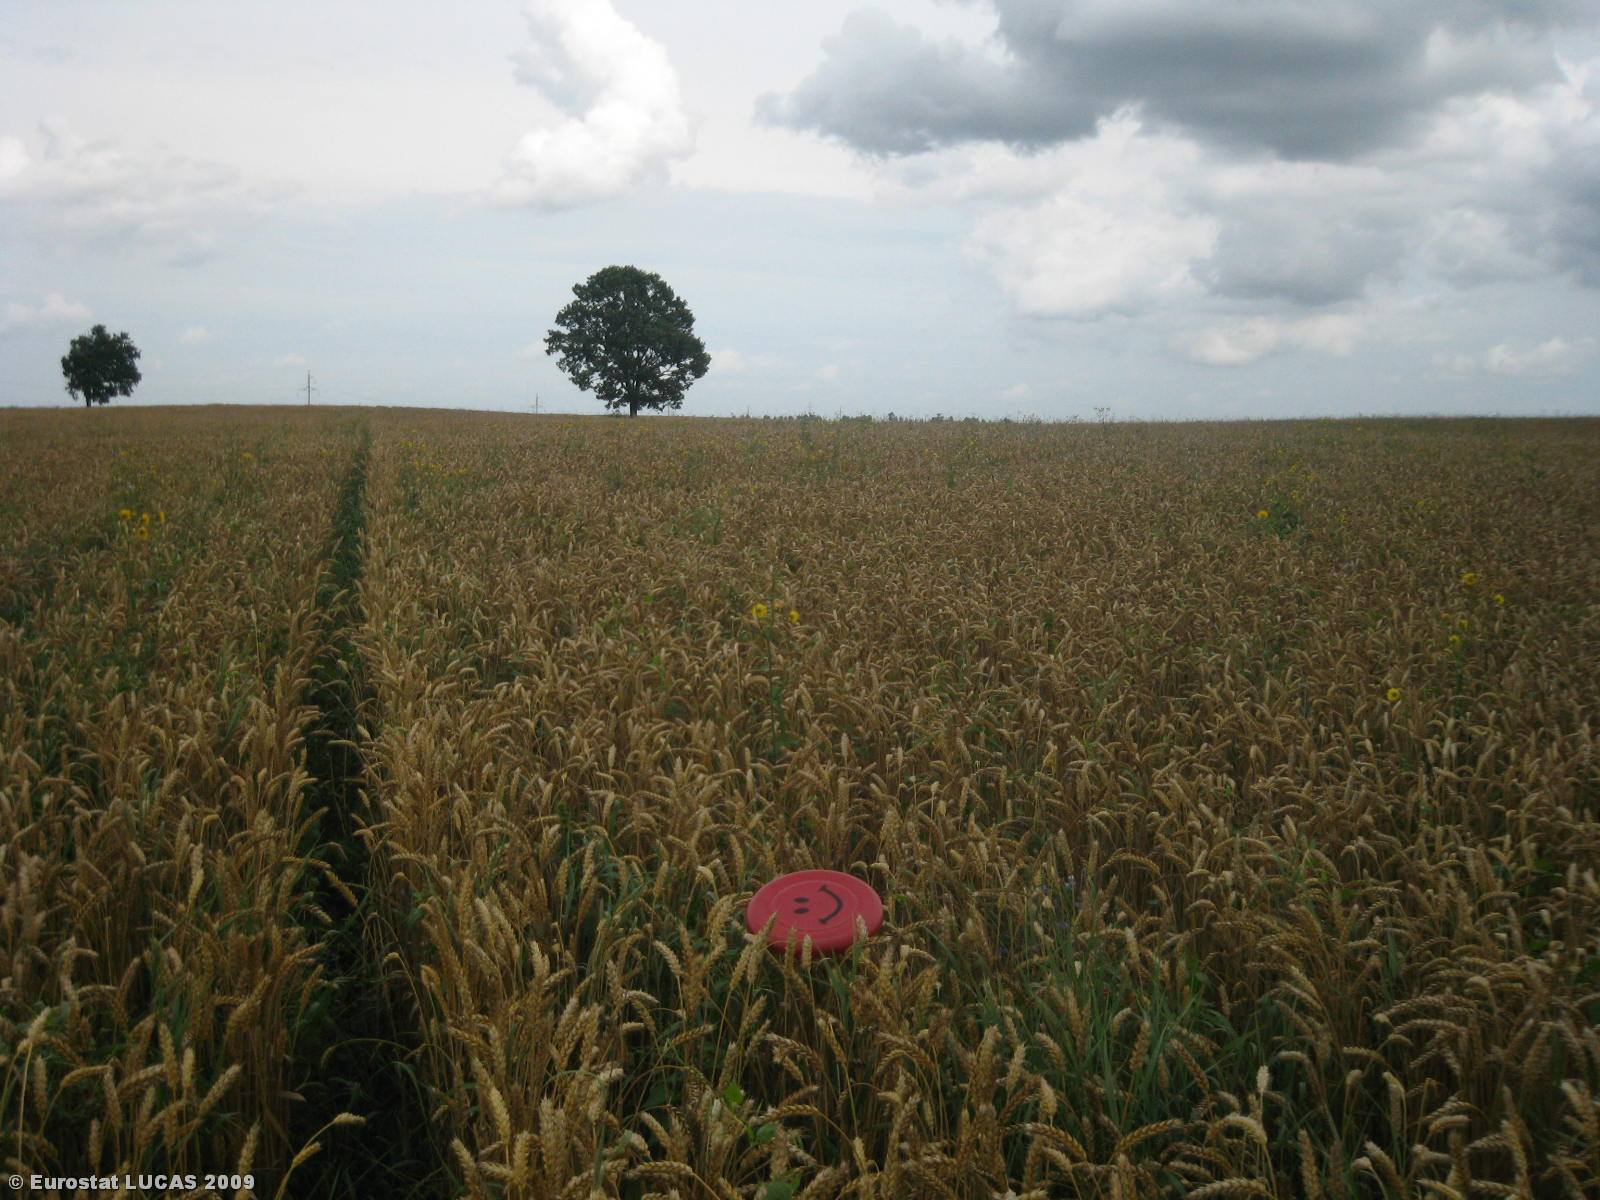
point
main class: Cropland
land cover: Common wheat
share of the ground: > 75 %
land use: Agriculture (excluding fallow land and kitchen gardens)
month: July
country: LT
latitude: 55.0338
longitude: 23.6487
